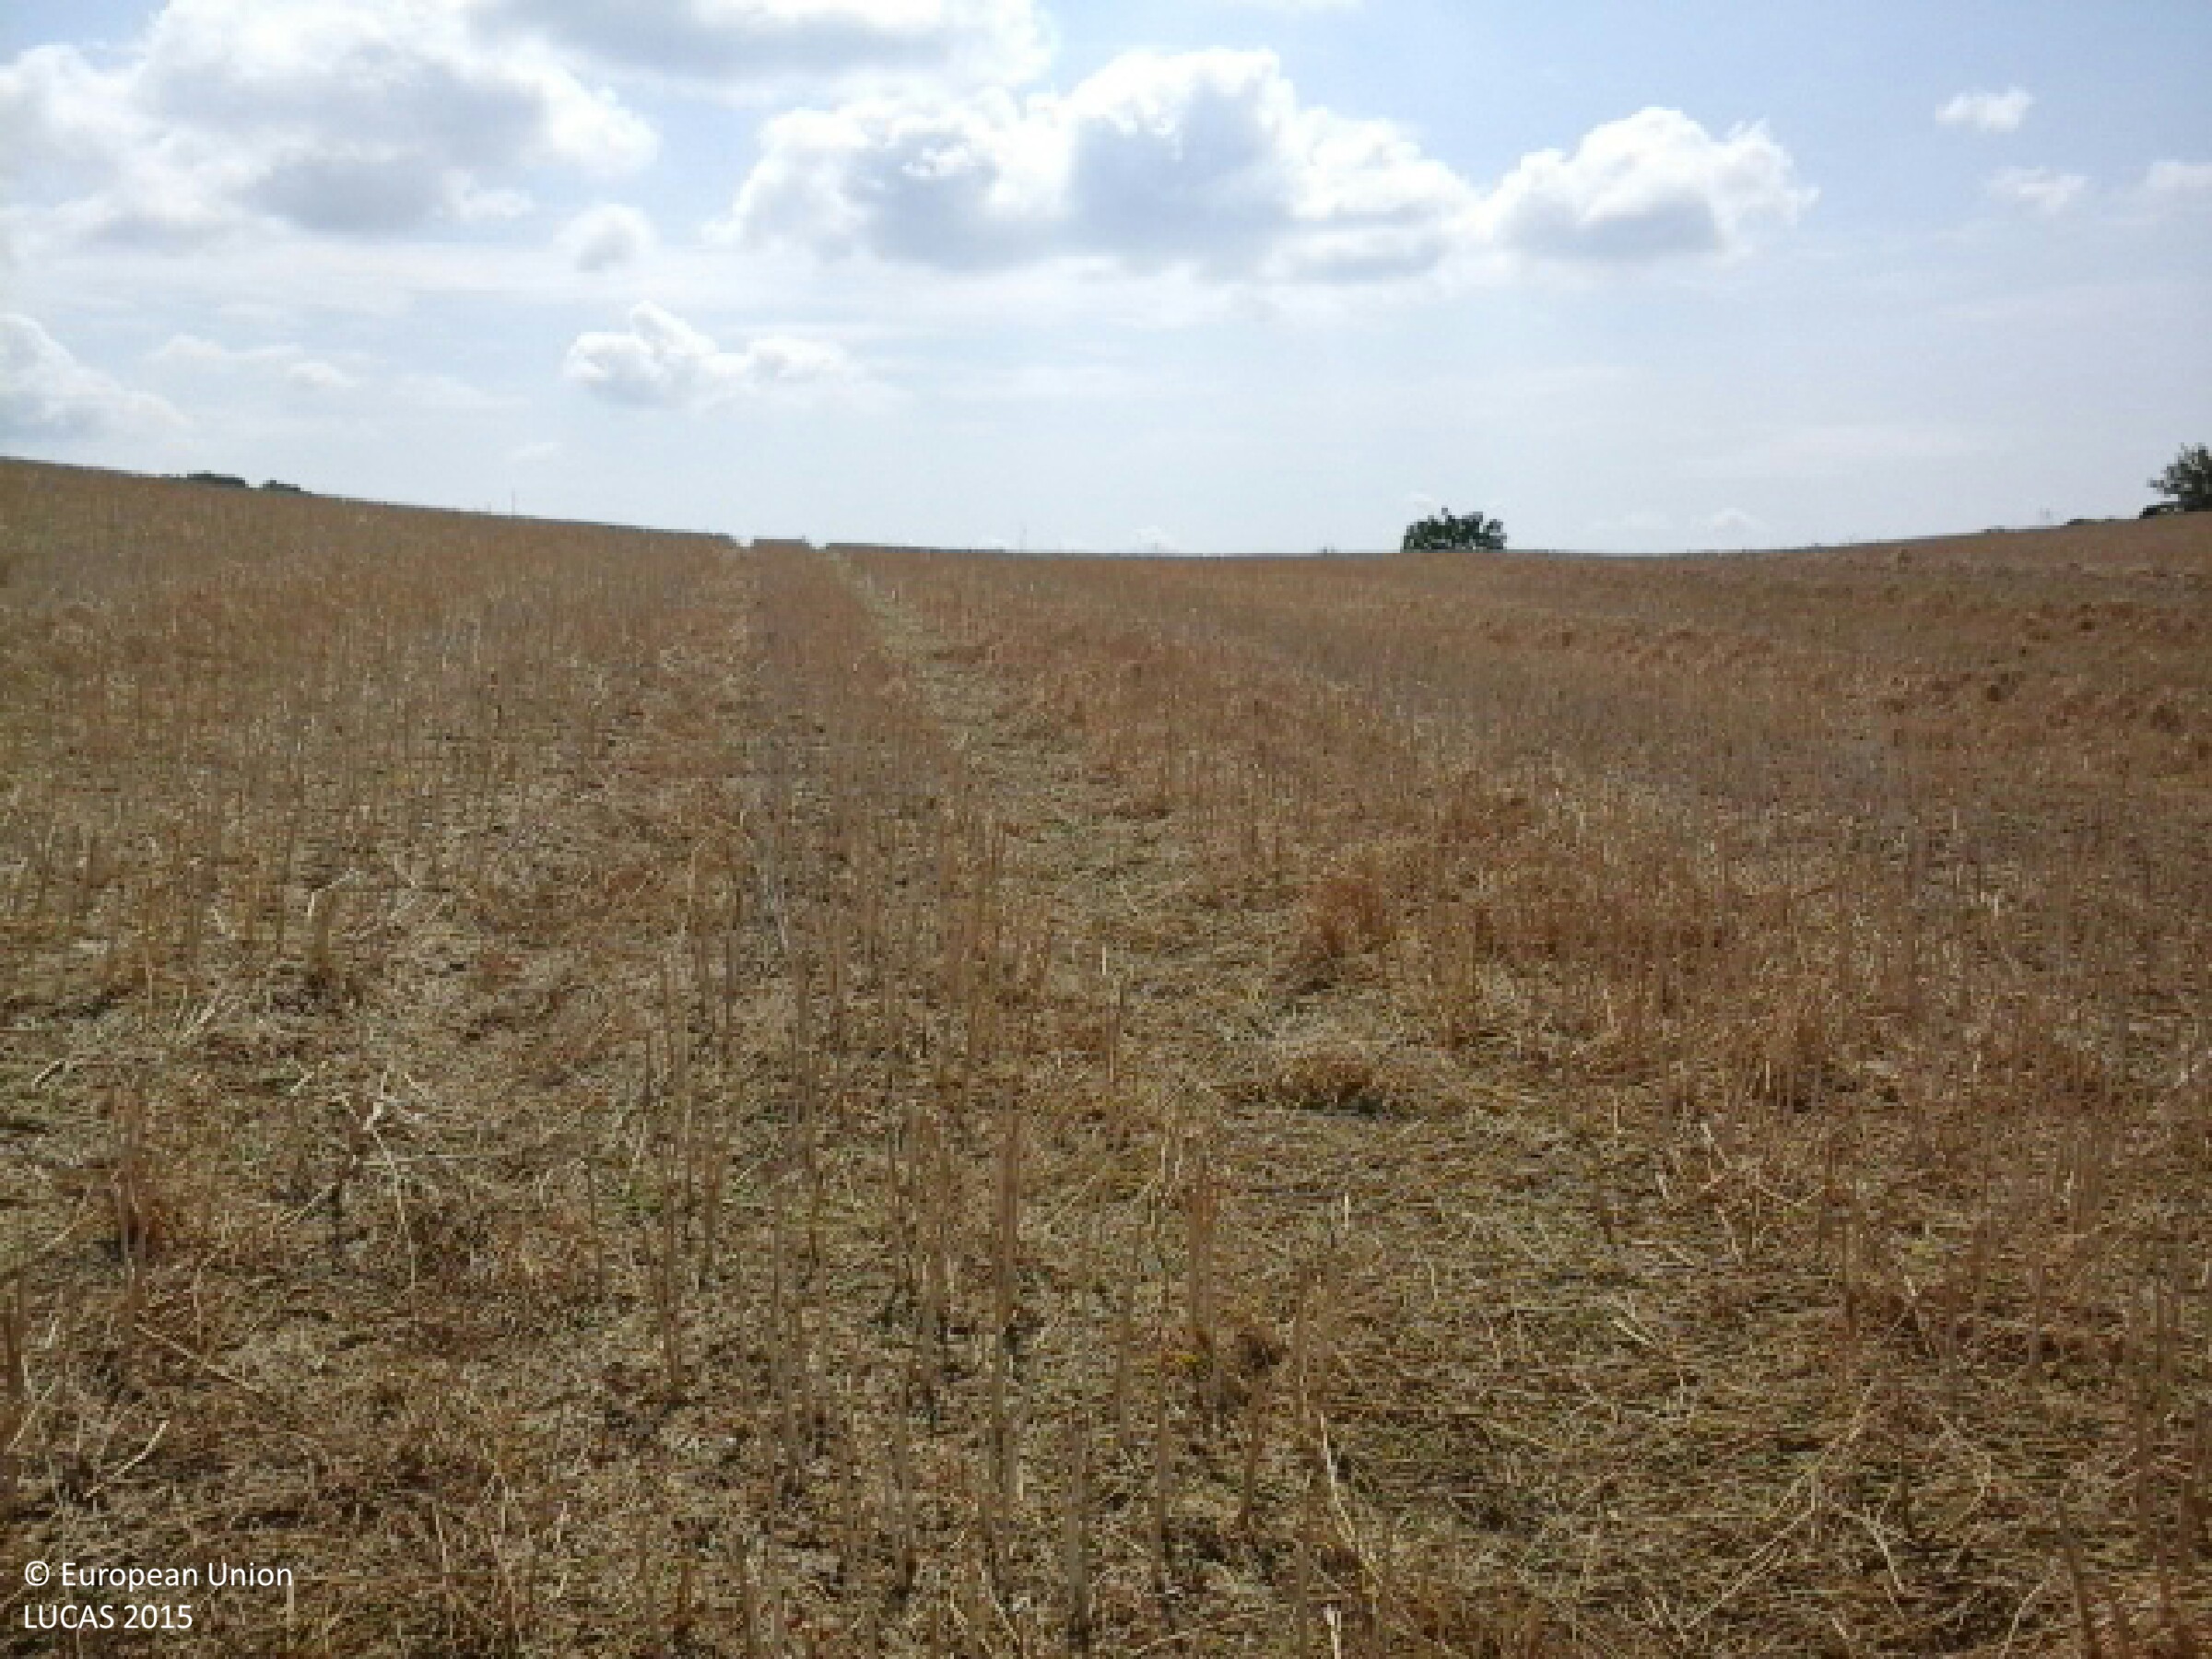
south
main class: Cropland
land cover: Rape and turnip rape
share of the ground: 10 - 25 %
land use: Agriculture (excluding fallow land and kitchen gardens)
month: August
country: HU
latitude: 47.5822
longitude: 18.5638
